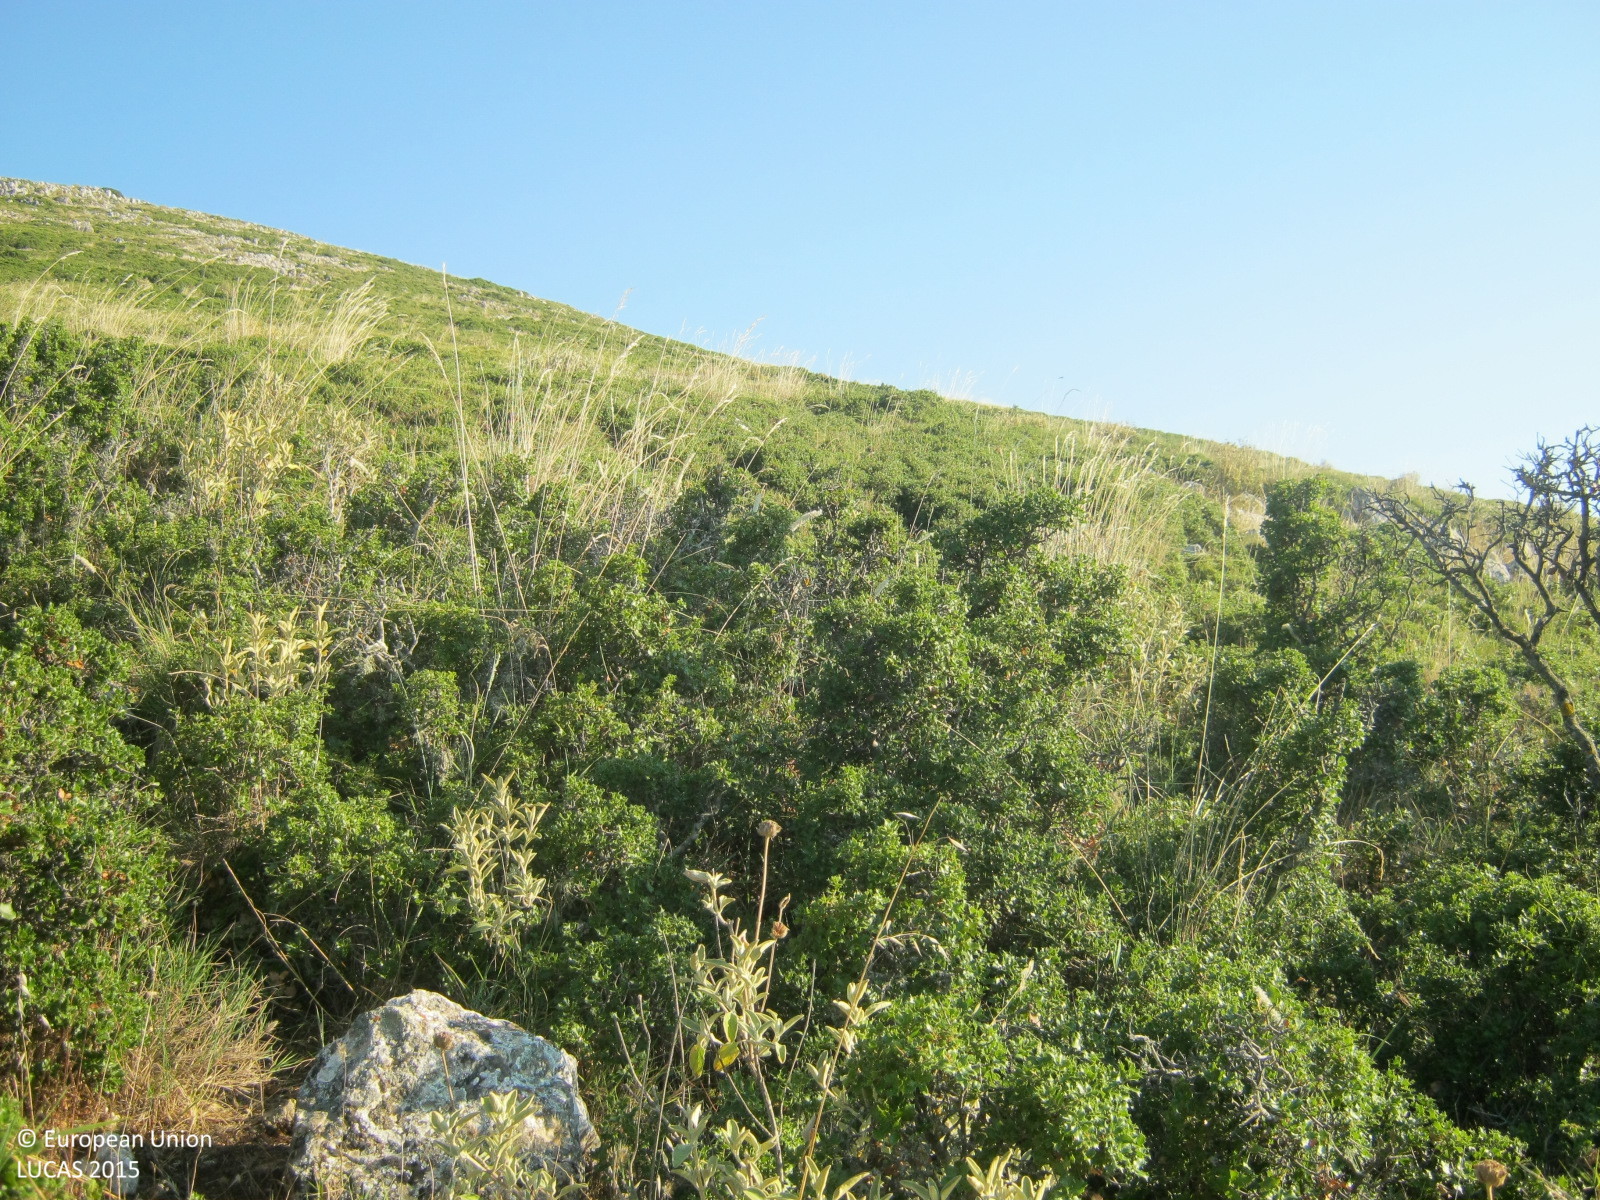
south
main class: Shrubland
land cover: Shrubland without tree cover
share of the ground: > 75 %
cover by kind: shrubs 85 %, unconsolidated bare surface 10 %, herbaceous plants 5 %
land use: Agriculture (excluding fallow land and kitchen gardens)
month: July
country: GR
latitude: 37.7758
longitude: 22.8096
